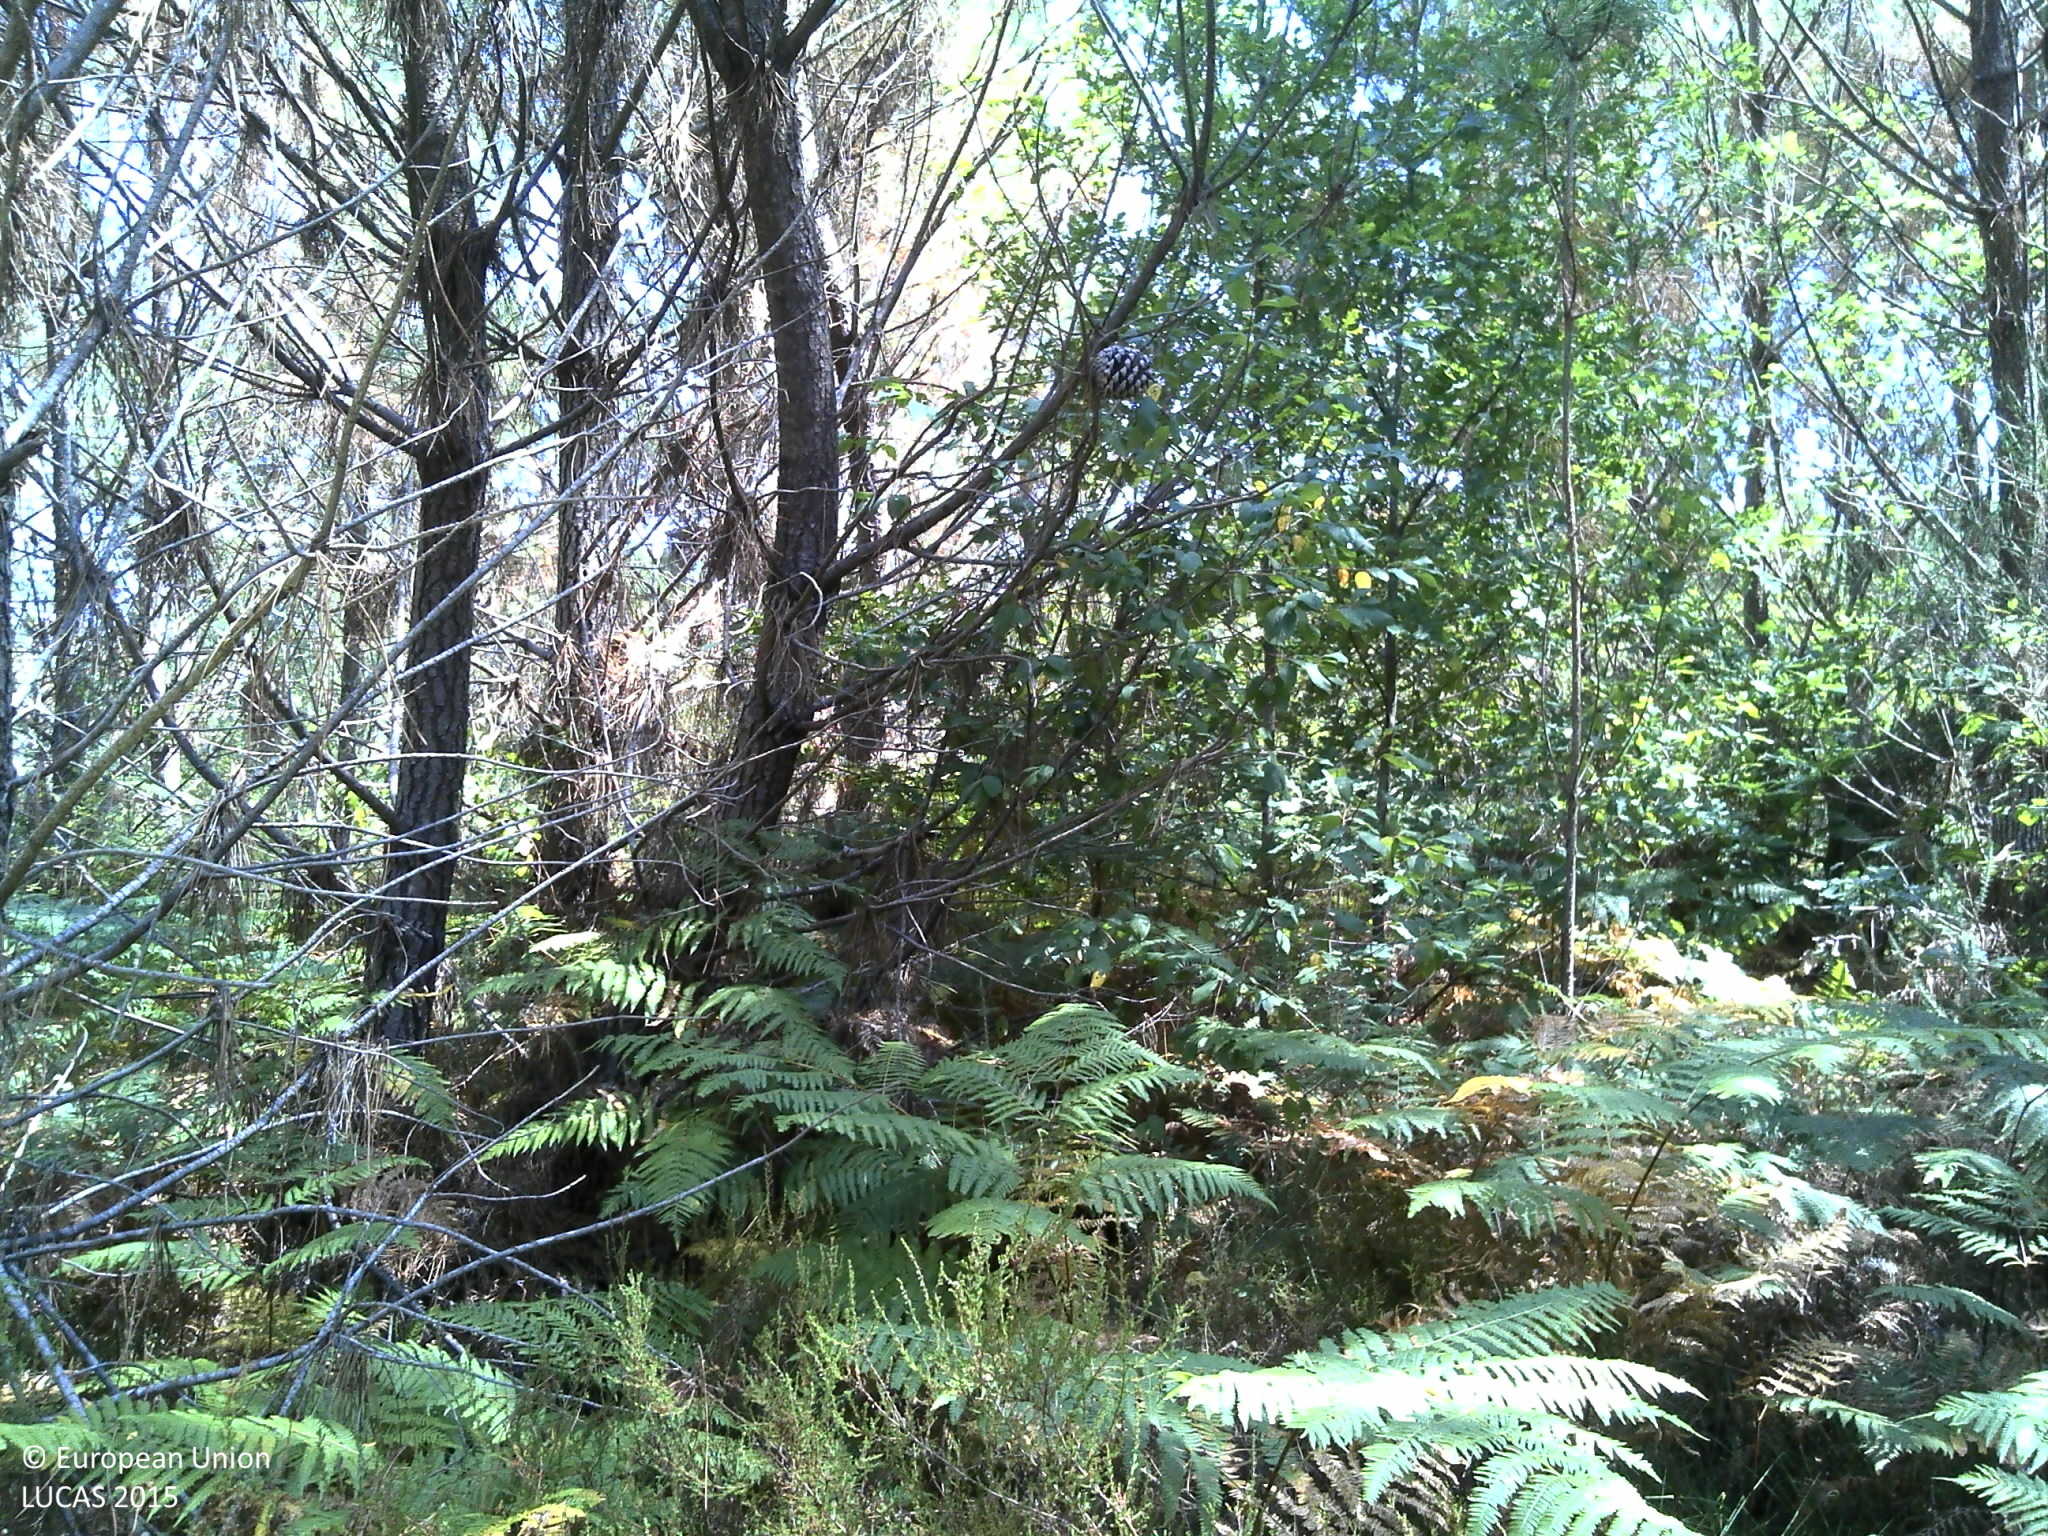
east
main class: Woodland
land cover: Pine dominated coniferous woodland
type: coniferous forest of the mediterranean region
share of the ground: > 75 %
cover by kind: coniferous forest trees 60 %, shrubs 30 %, herbaceous plants 5 %, lichens and mosses 5 %
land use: Forestry
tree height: > 5 m
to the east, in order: Pine dominated coniferous woodland; Ditches and canals; Tracks; Ditches and canals; Grassland without tree/shrub cover; Pine dominated coniferous woodland; Ditches and canals; Grass margins; Paved roads, cycling and walking lanes; Grass margins; Ditches and canals; Grass margins; Pine dominated coniferous woodland
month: August
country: FR
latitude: 44.9830
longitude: -0.9935
